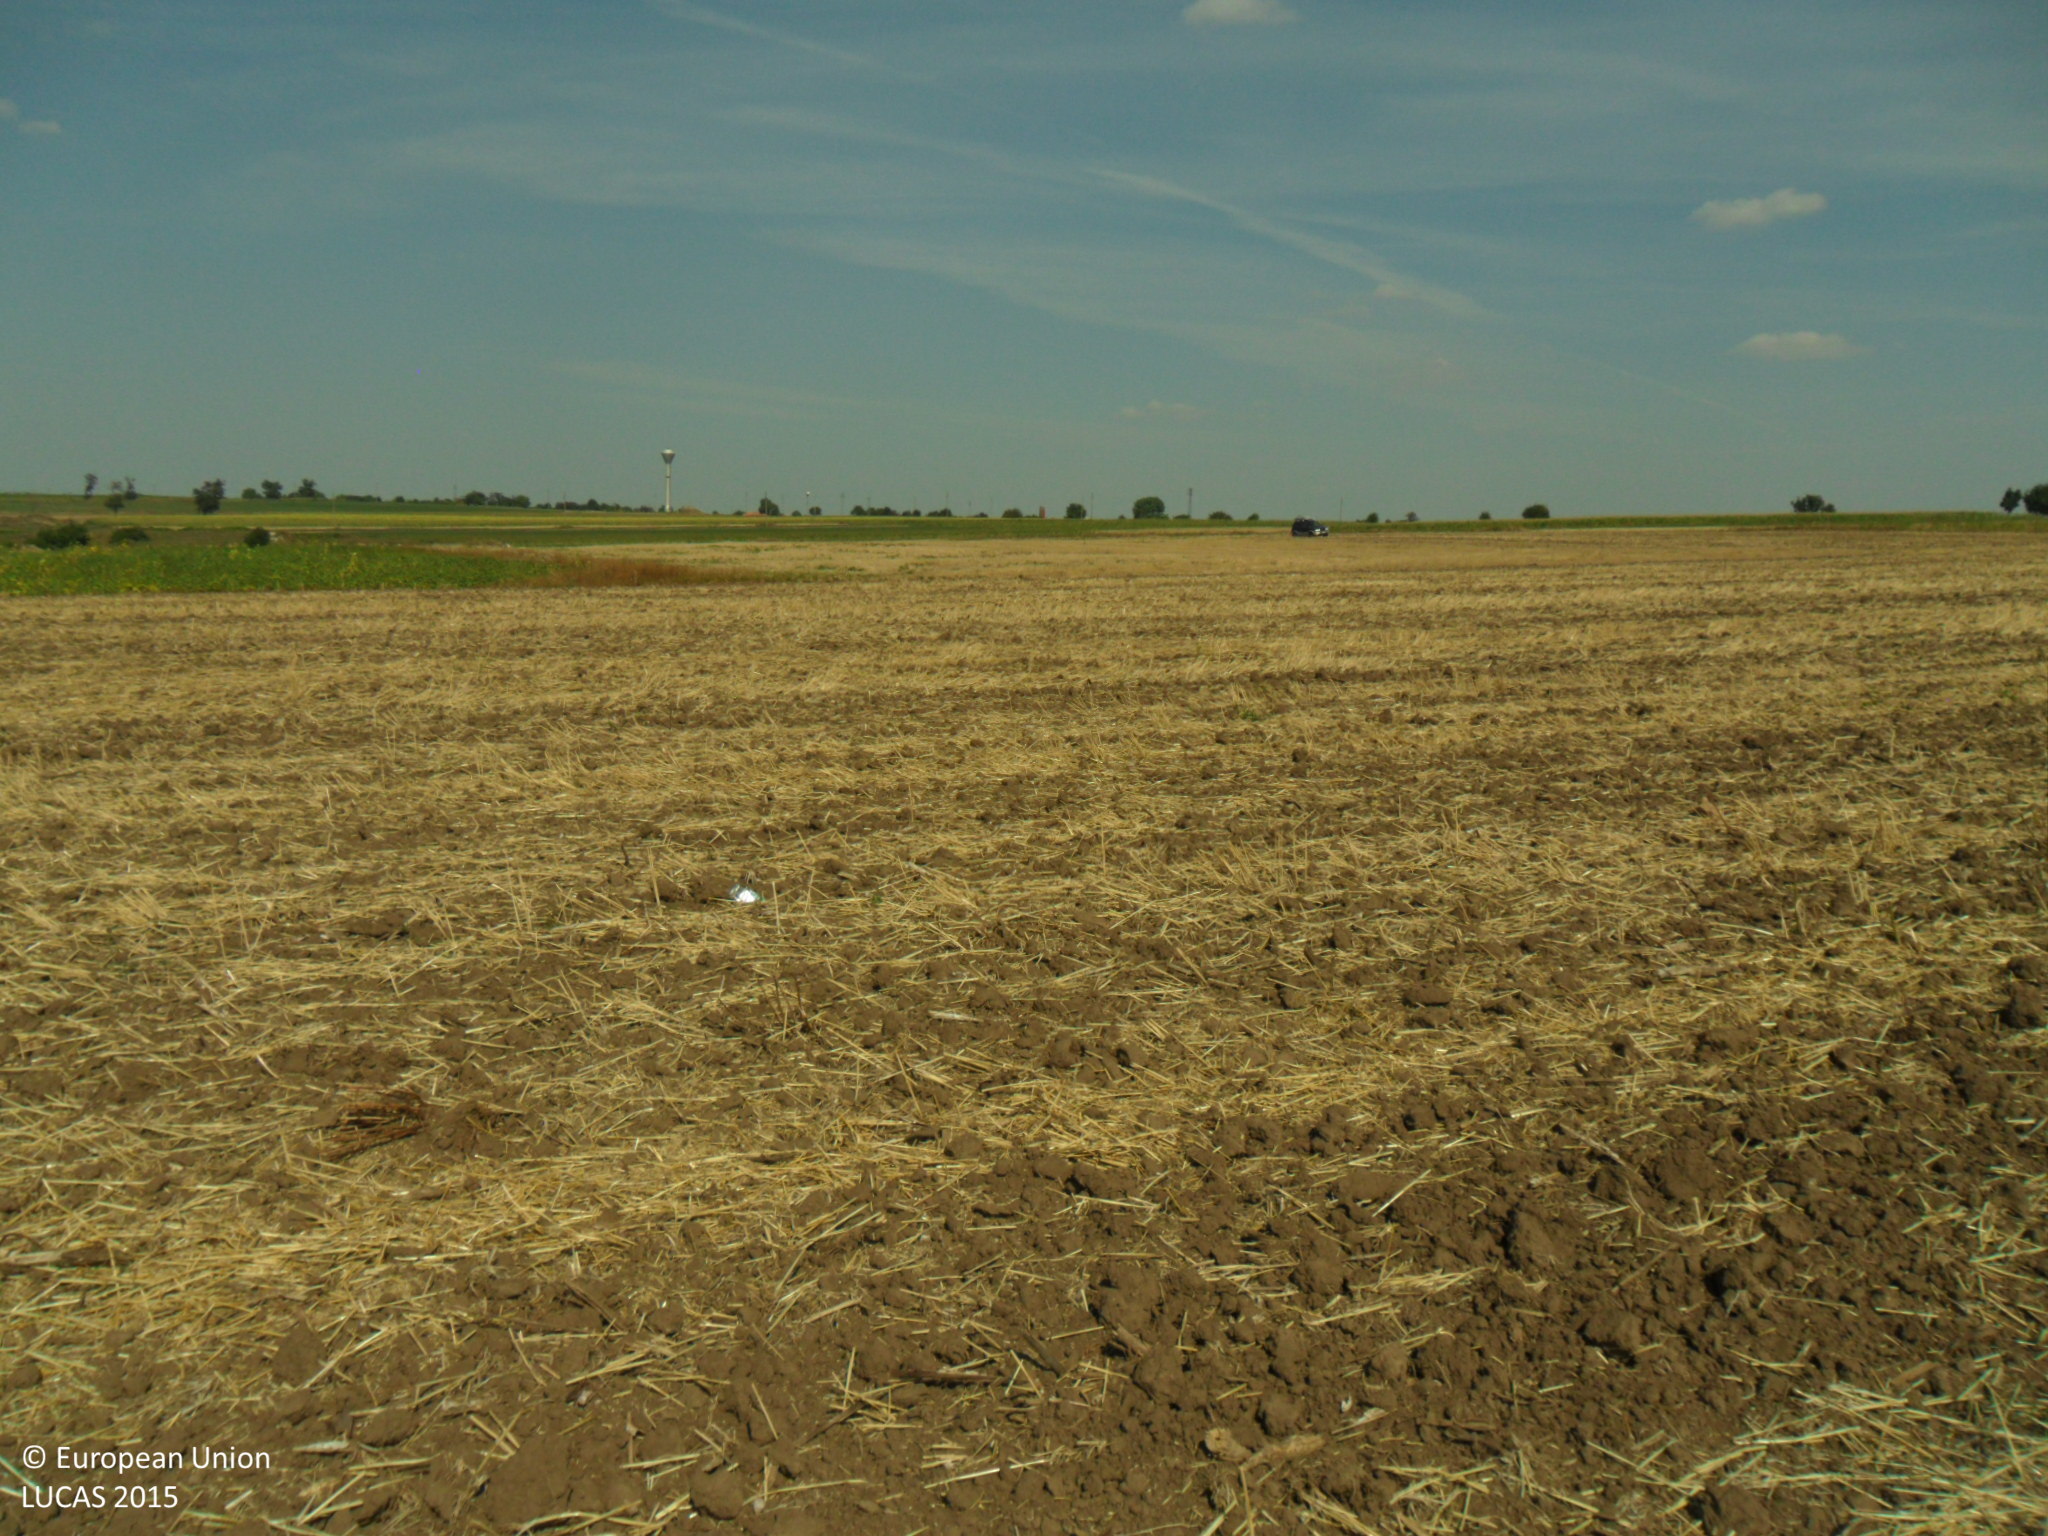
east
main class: Cropland
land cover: Common wheat
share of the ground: < 10 %
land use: Agriculture (excluding fallow land and kitchen gardens)
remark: Harvested field
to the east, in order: Common wheat; Lucerne
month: August
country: BG
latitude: 43.6294
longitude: 27.1396
